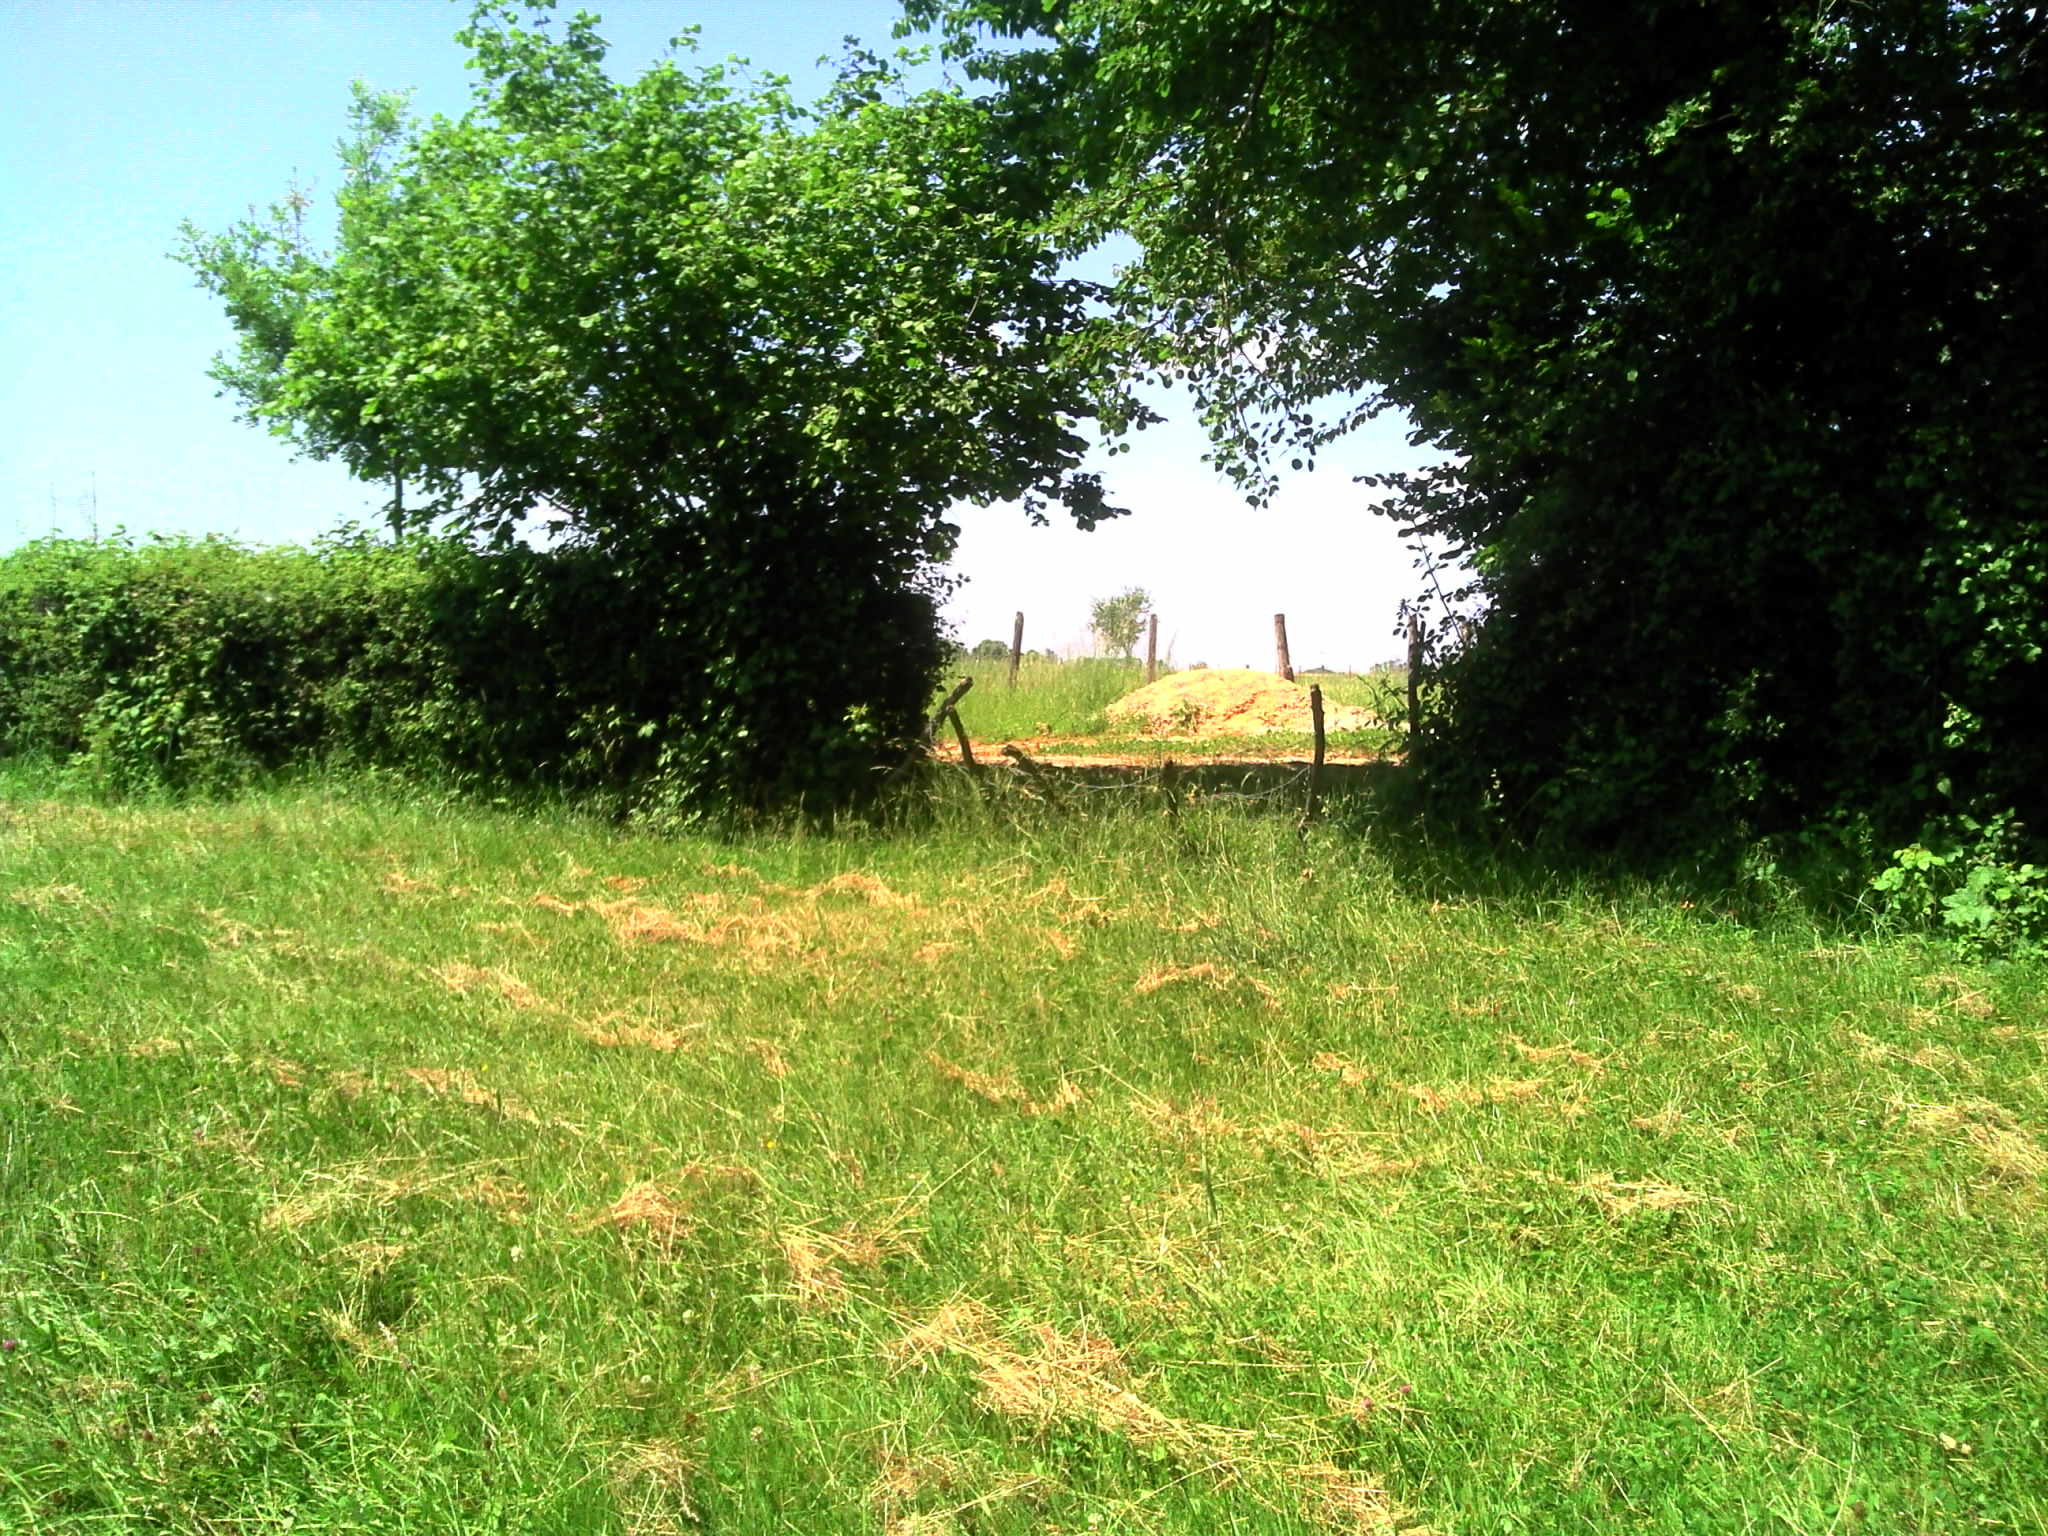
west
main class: Grassland
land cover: Grassland without tree/shrub cover
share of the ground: > 75 %
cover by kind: herbaceous plants 100 %
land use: Agriculture (excluding fallow land and kitchen gardens)
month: May
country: FR
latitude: 46.5282
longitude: 5.1133
